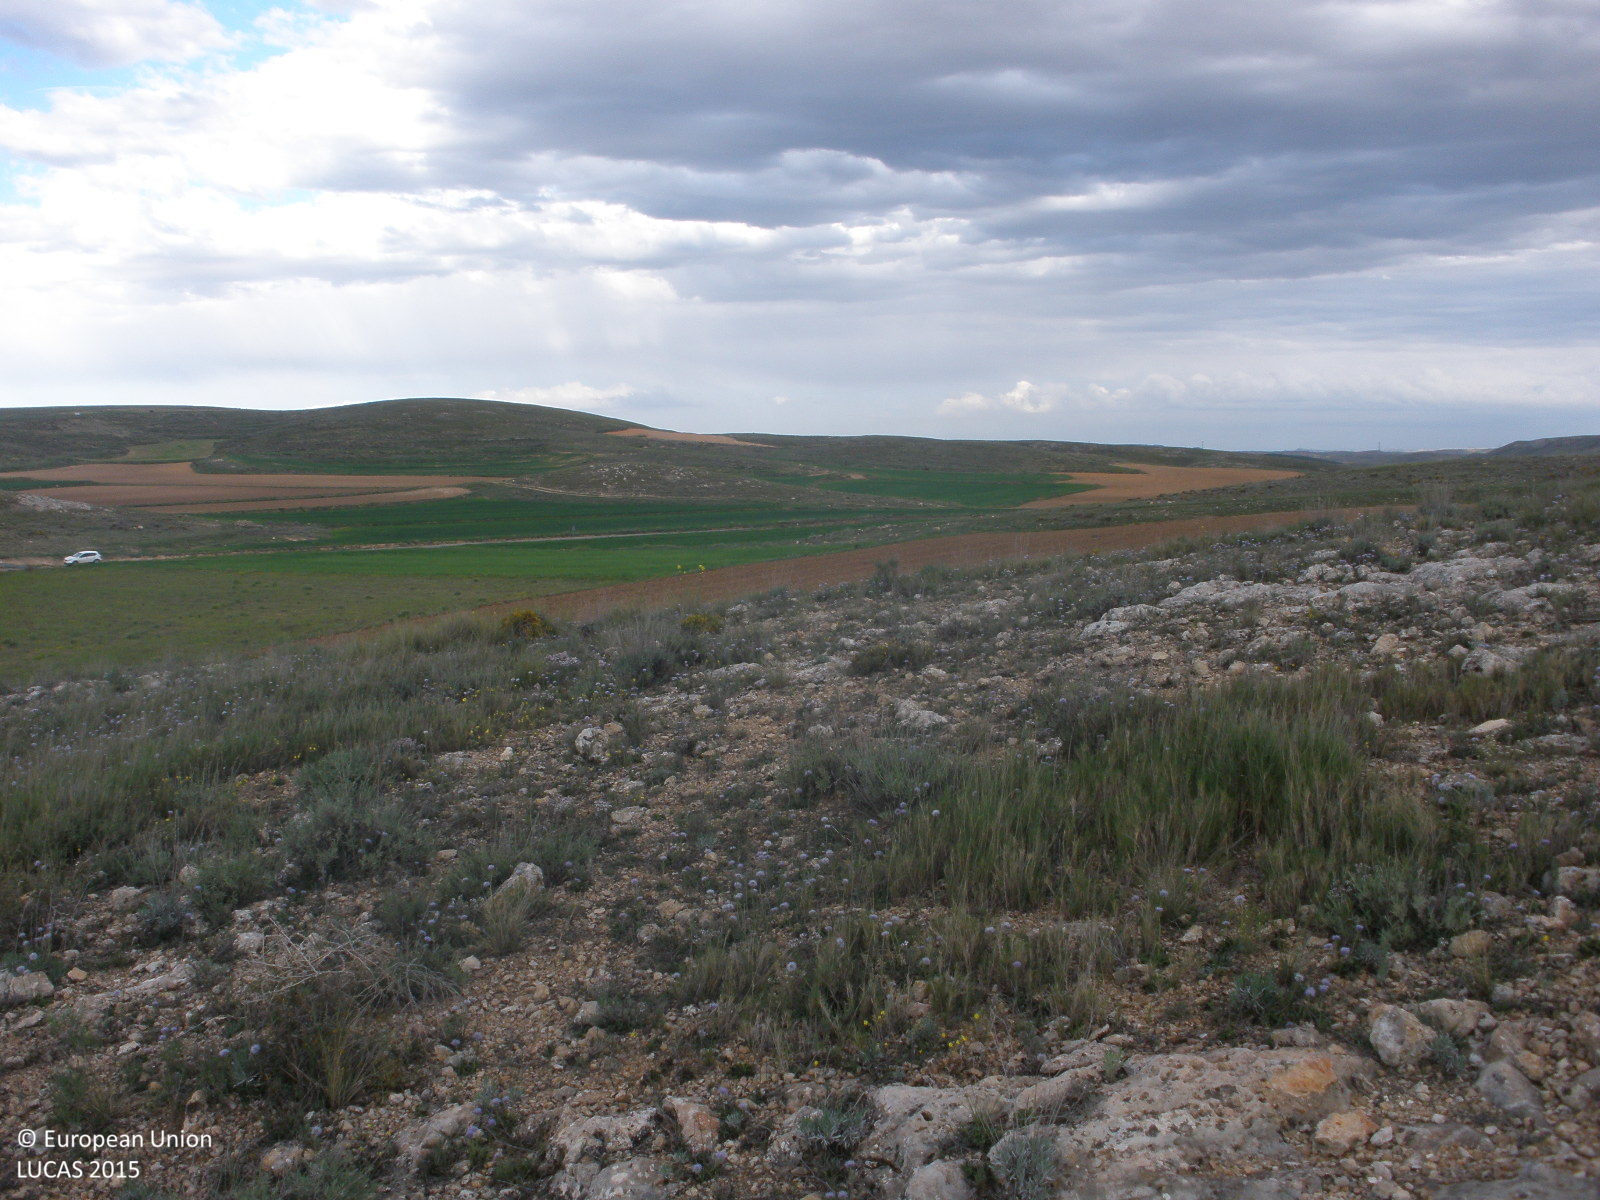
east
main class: Shrubland
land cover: Shrubland without tree cover
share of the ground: 25 - 50 %
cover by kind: herbaceous plants 50 %, shrubs 30 %, consolidated bare surface 20 %
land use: Agriculture (excluding fallow land and kitchen gardens)
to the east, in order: Shrubland without tree cover; Other bare soil; Shrubland without tree cover; Common wheat; Shrubland without tree cover; Other bare soil; Grass margins; Barley; Shrubland without tree cover; Barley
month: May
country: ES
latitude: 41.0795
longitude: -0.9077
